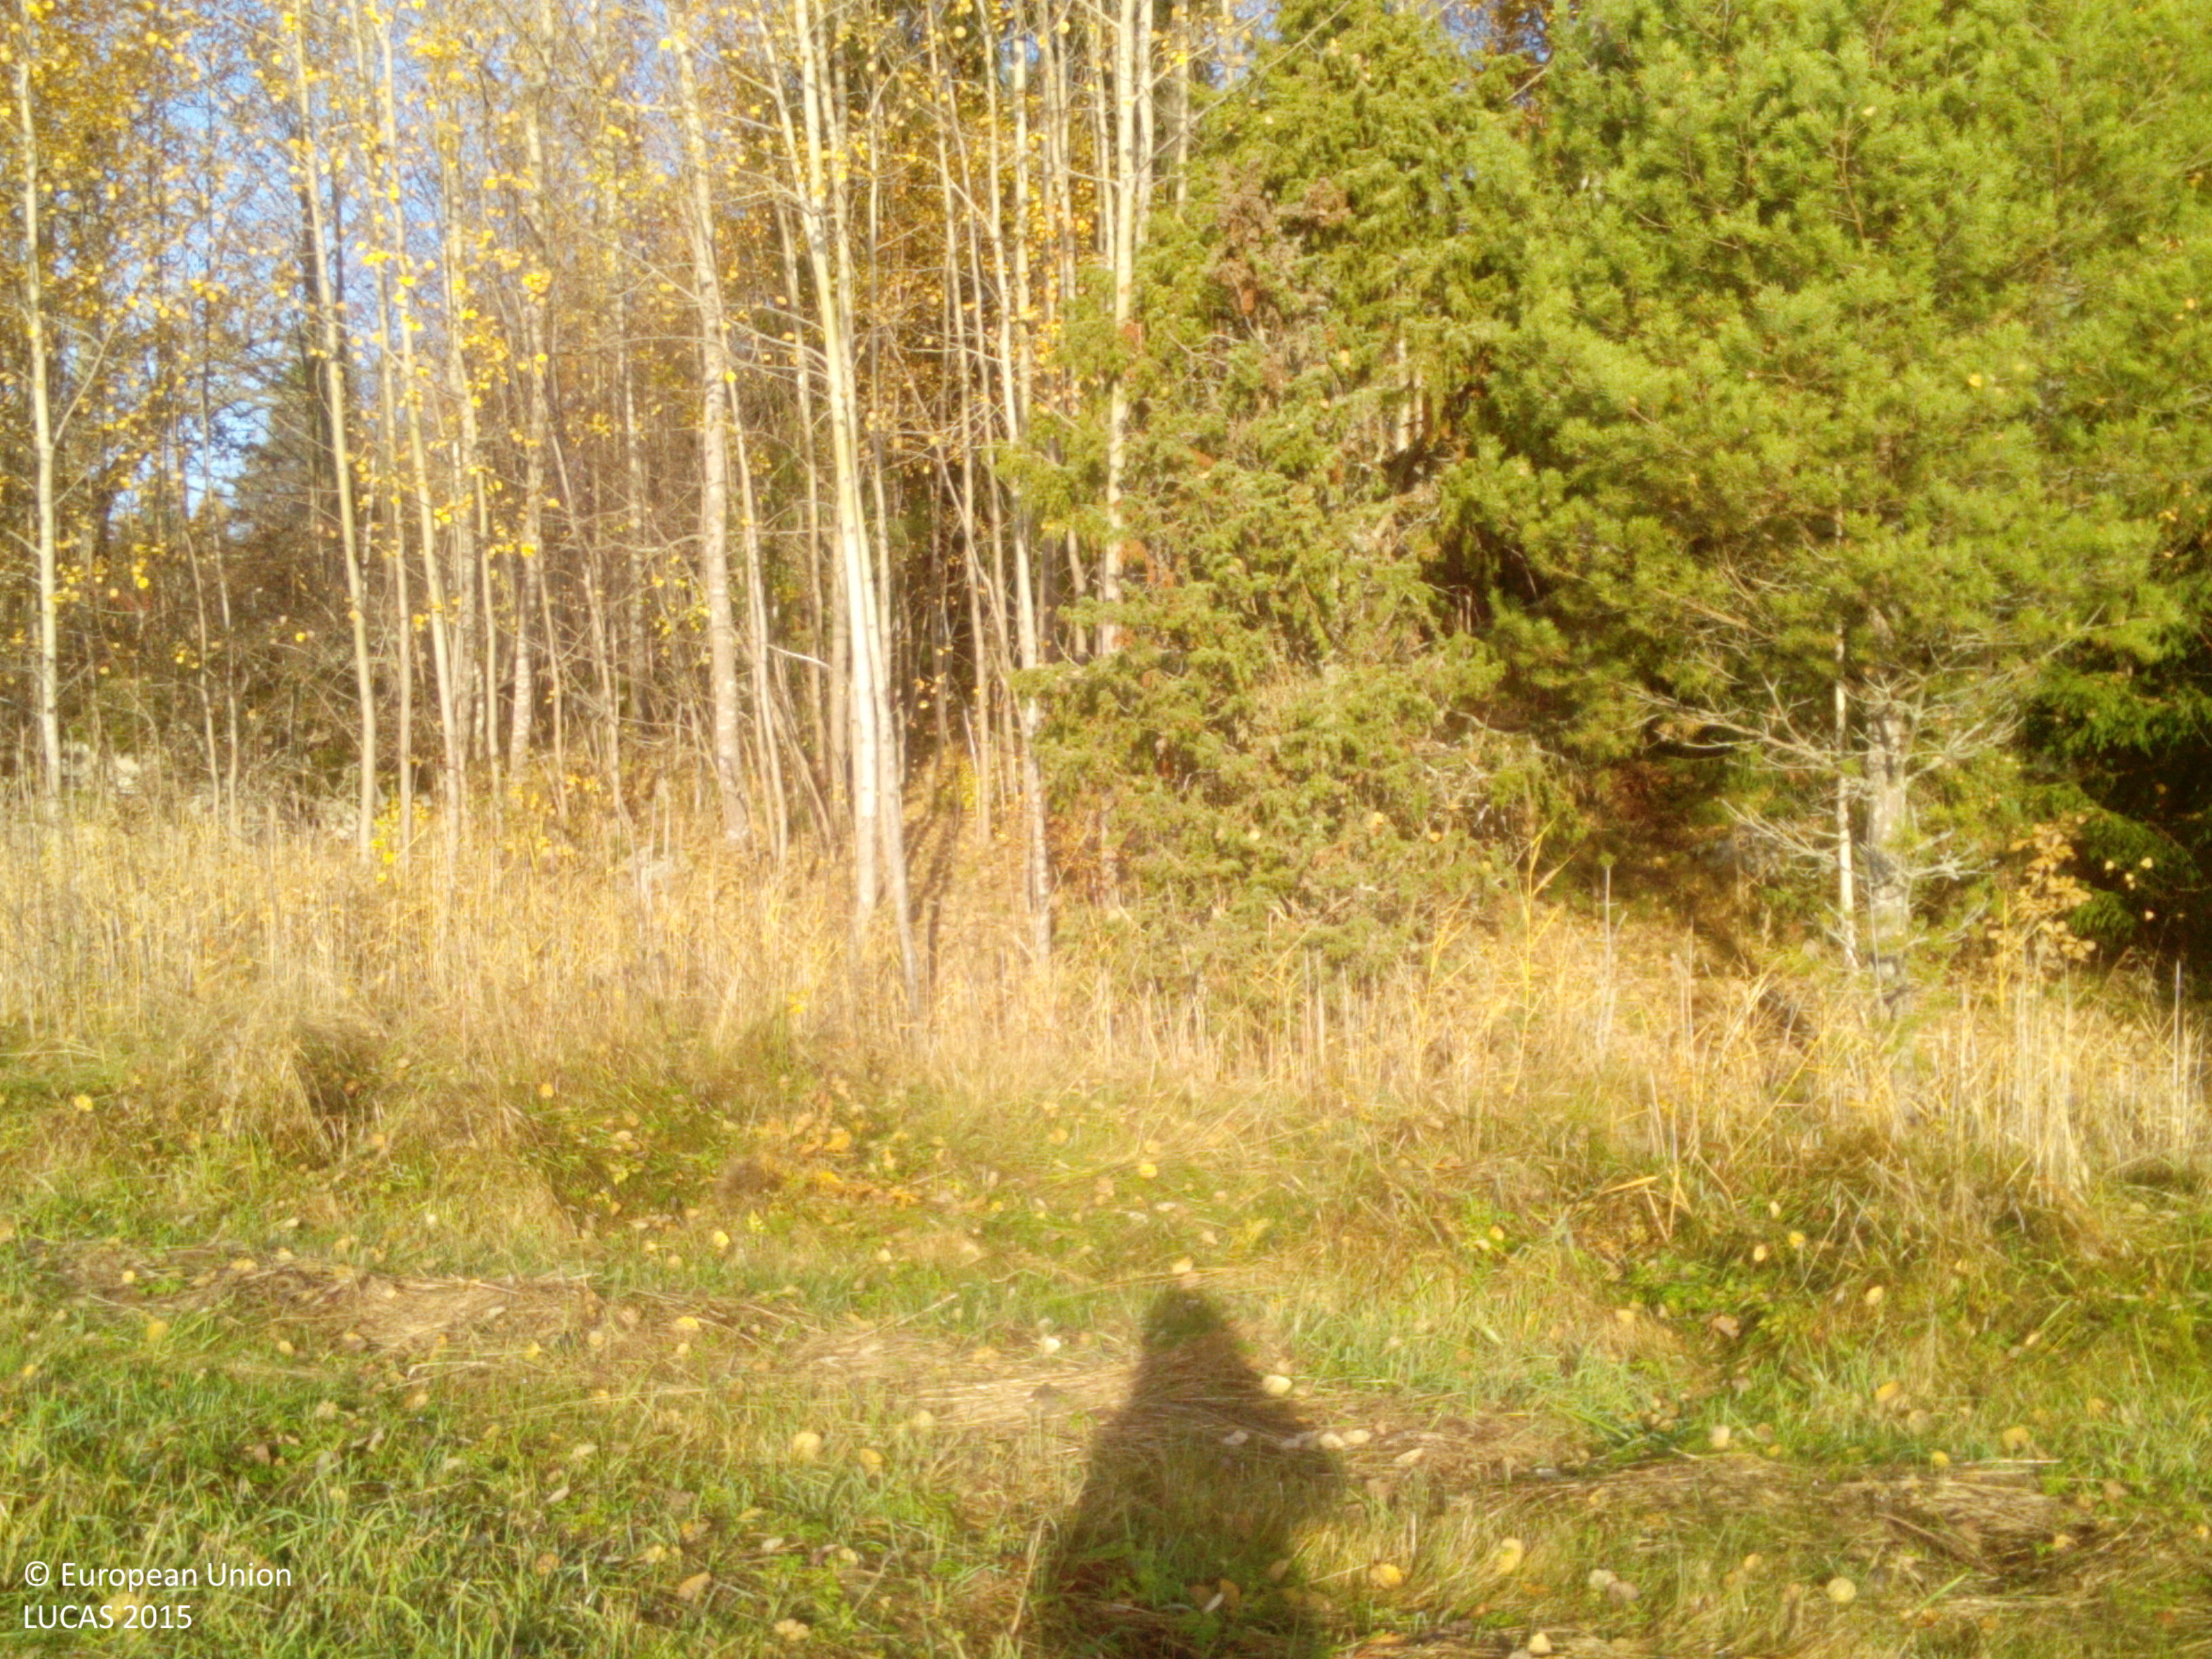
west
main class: Grassland
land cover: Grassland without tree/shrub cover
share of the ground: > 75 %
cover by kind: herbaceous plants 100 %
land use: Agriculture (excluding fallow land and kitchen gardens)
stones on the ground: < 10 %
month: October
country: SE
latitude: 59.0555
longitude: 16.4976
